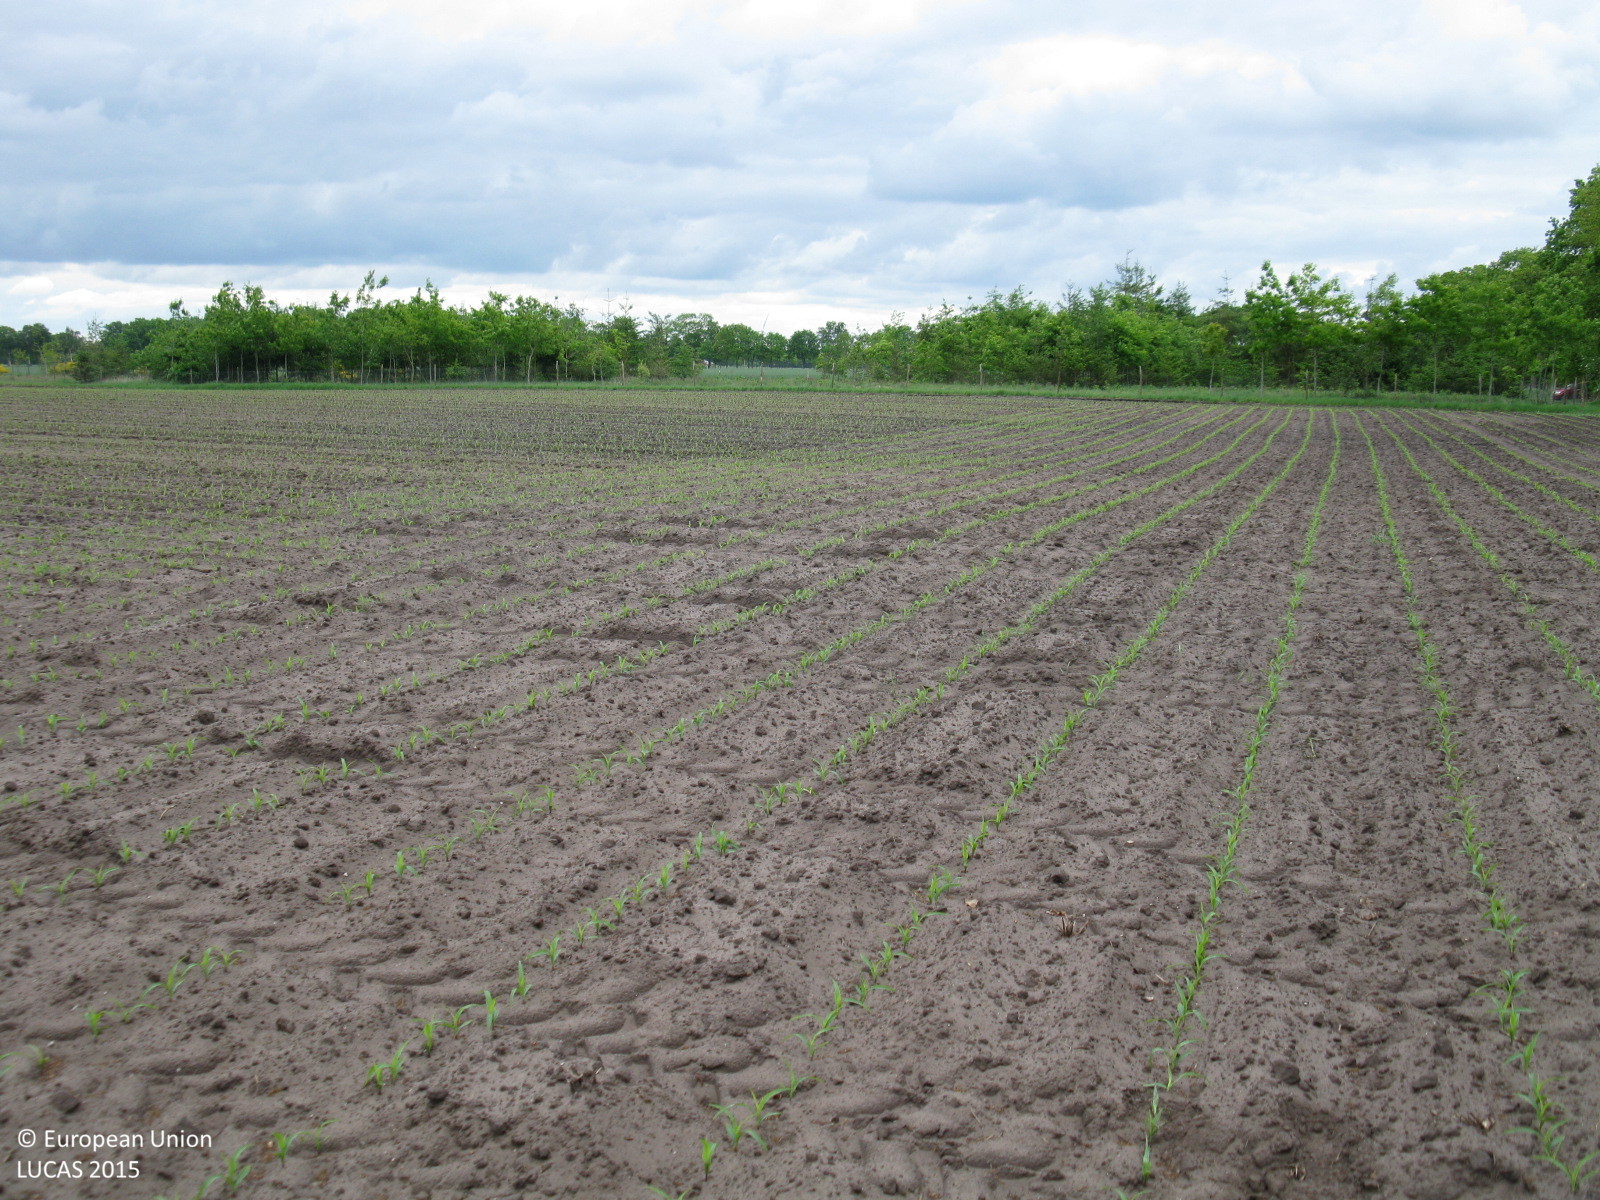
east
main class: Cropland
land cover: Maize
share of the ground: < 10 %
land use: Agriculture (excluding fallow land and kitchen gardens)
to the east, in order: Maize; Fences; Other coniferous woodland; Fences; Grass margins; Ditches and canals; Grass margins; Tracks; Triticale
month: May
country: DE
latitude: 52.9708
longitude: 7.9308
